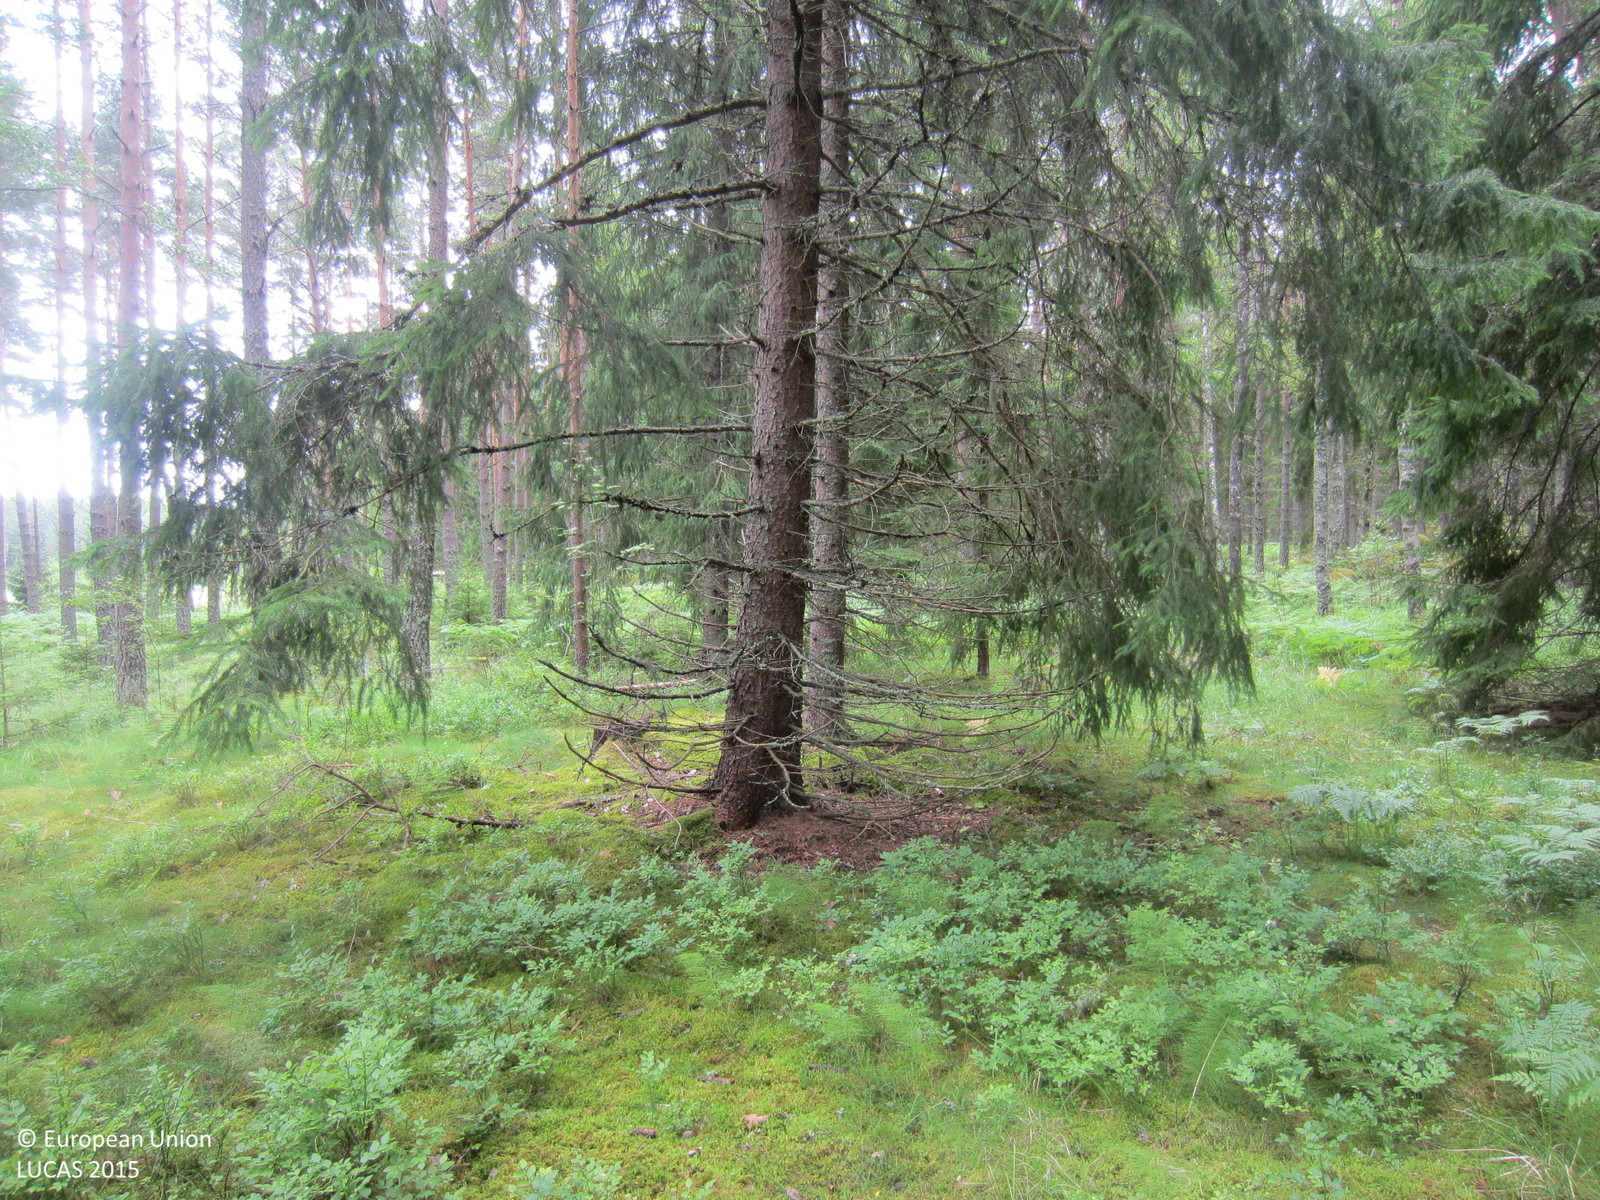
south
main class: Woodland
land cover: Spruce dominated coniferous woodland
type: boreal forest
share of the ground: > 75 %
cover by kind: coniferous forest trees 70 %, herbaceous plants 10 %, lichens and mosses 10 %, broadleaved forest trees 5 %, shrubs 5 %
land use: Forestry
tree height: > 5 m
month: July
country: SE
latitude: 59.8241
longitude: 17.0376
